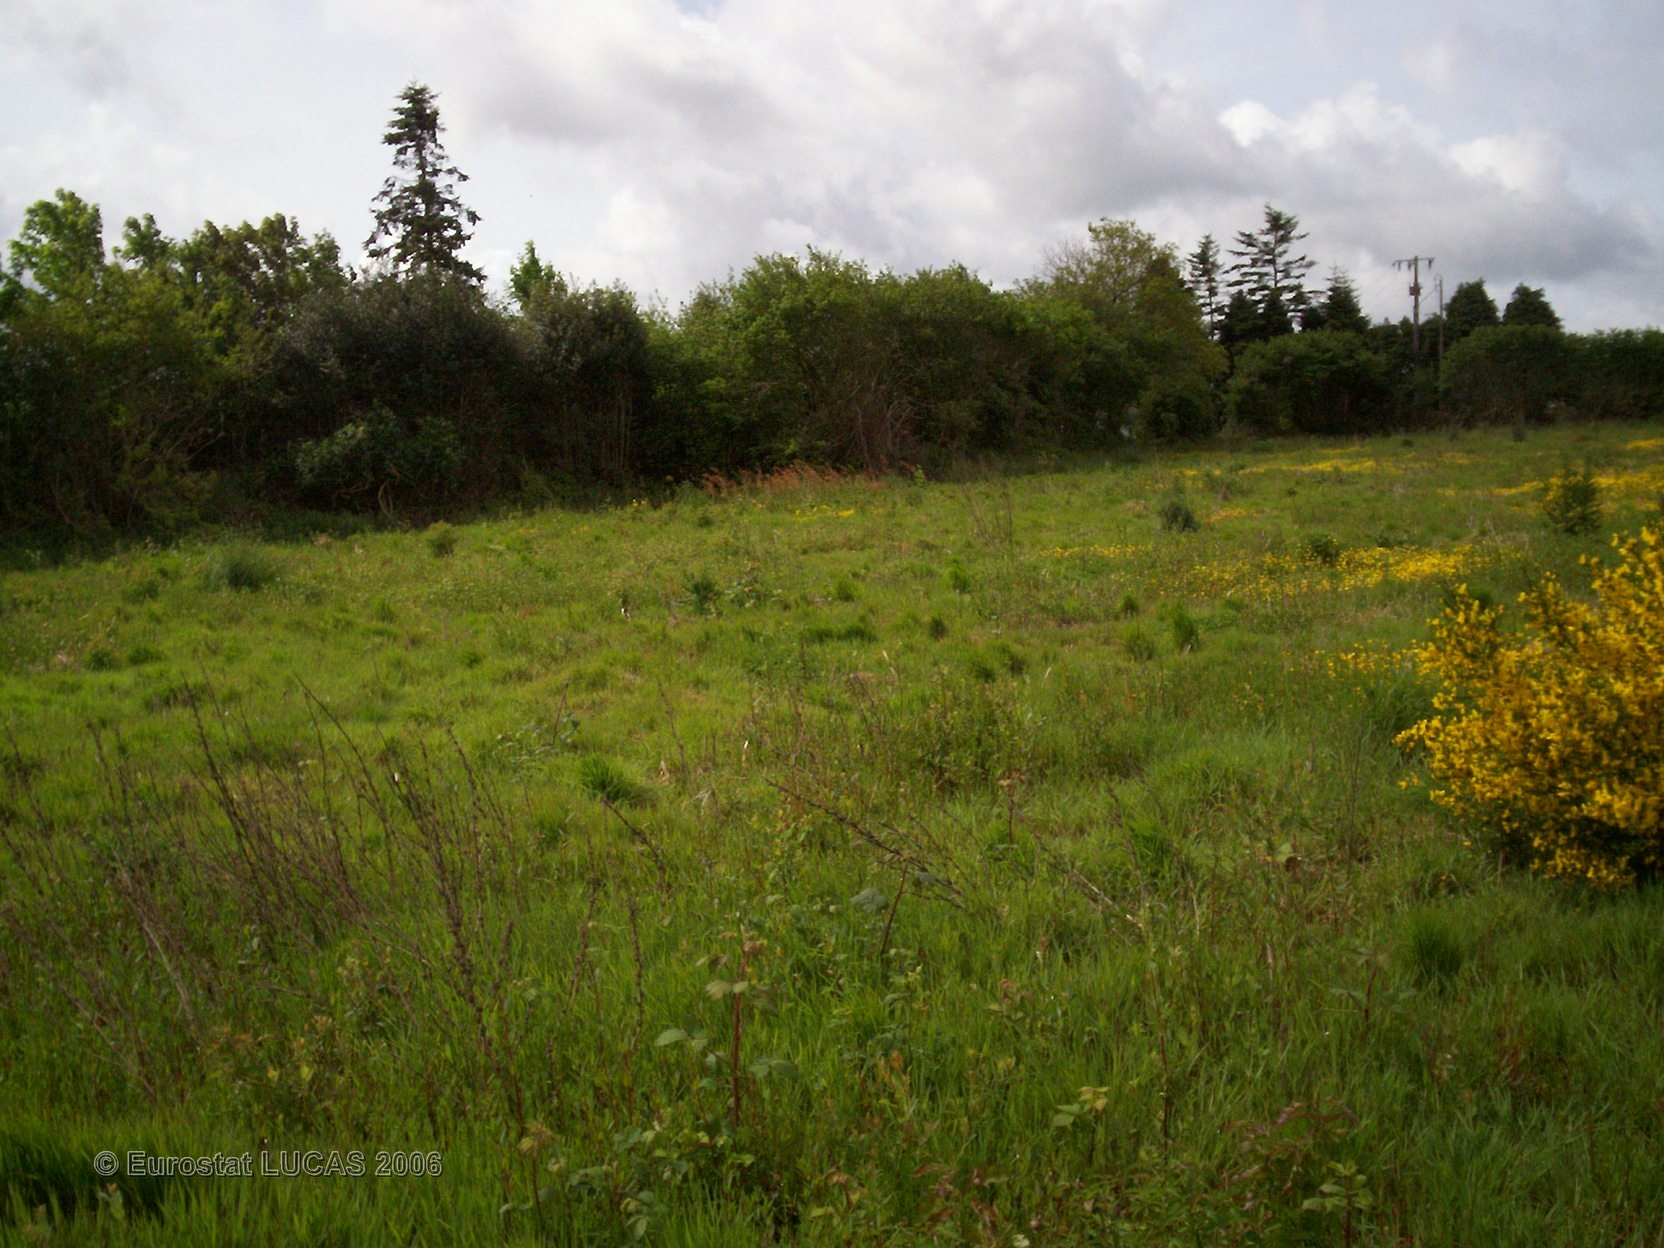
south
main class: Grassland
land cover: Grassland without tree/shrub cover
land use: Fallow land
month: May
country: FR
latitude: 48.0123
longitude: -3.9058
